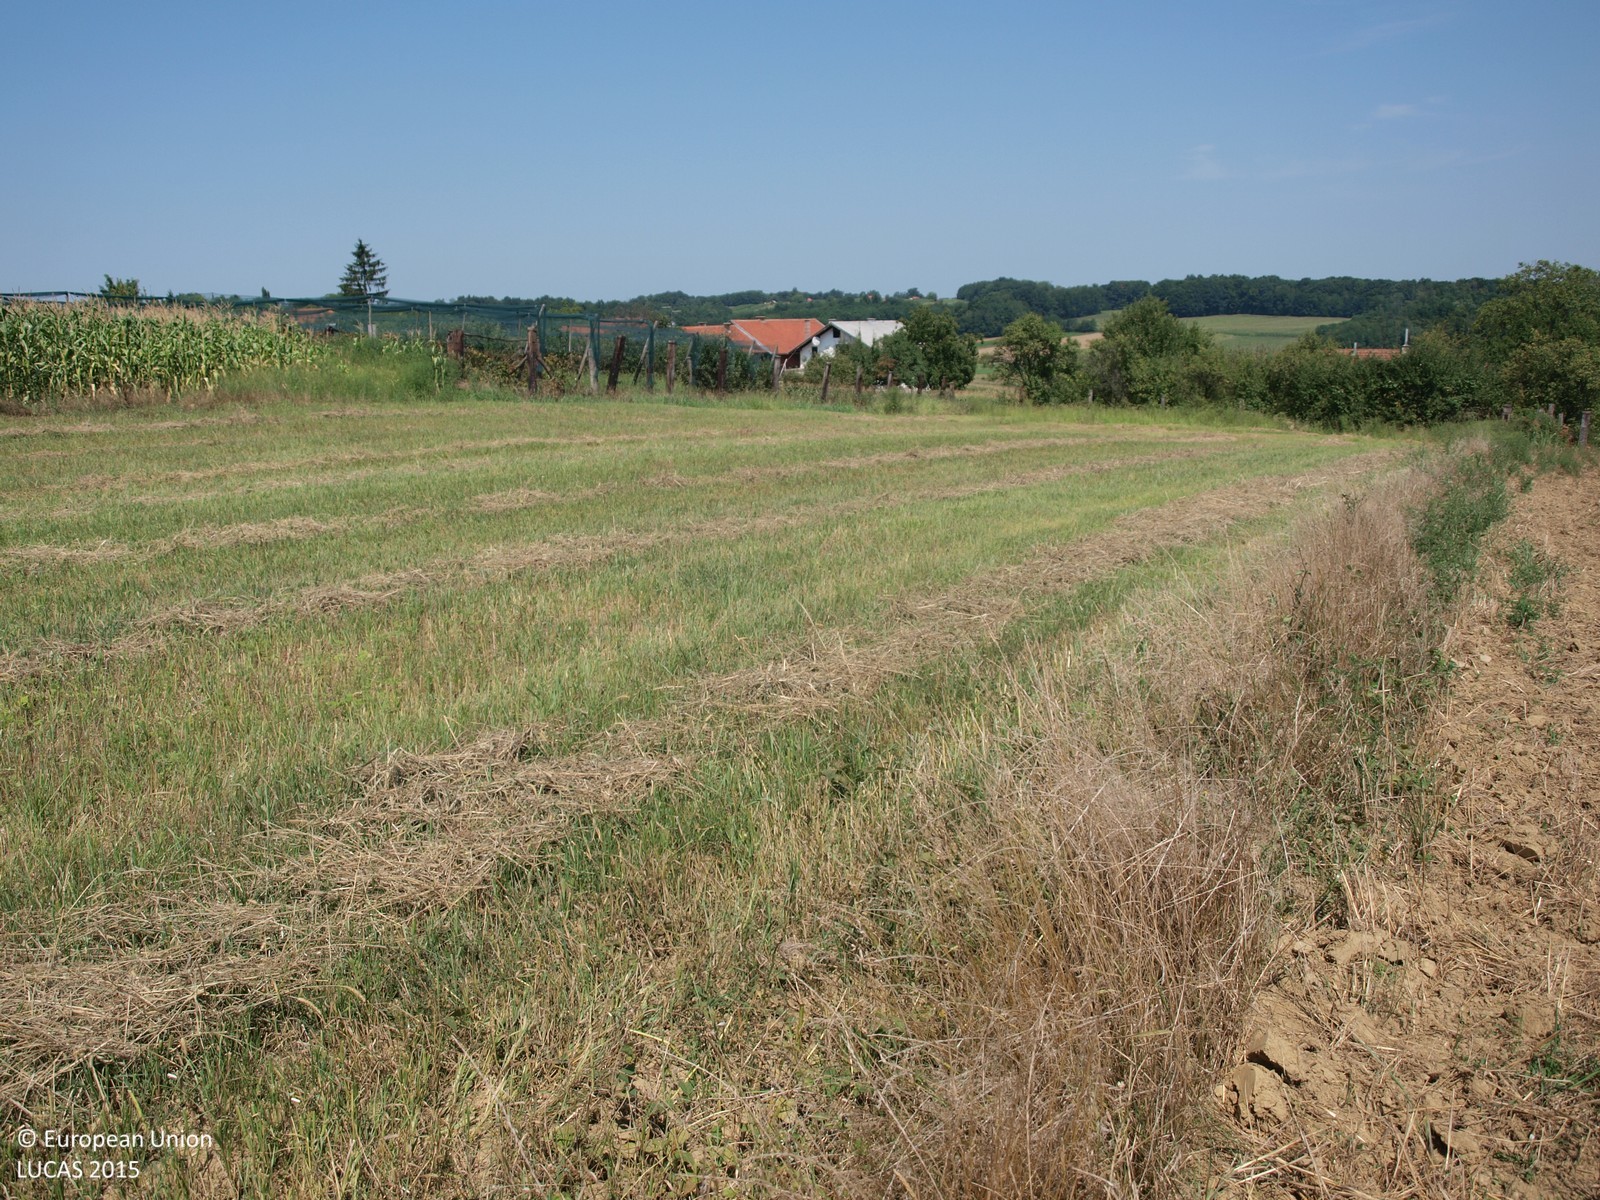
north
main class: Cropland
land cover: Oats
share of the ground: > 75 %
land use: Agriculture (excluding fallow land and kitchen gardens)
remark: Harvested field
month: August
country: HR
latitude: 45.9865
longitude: 16.5707
